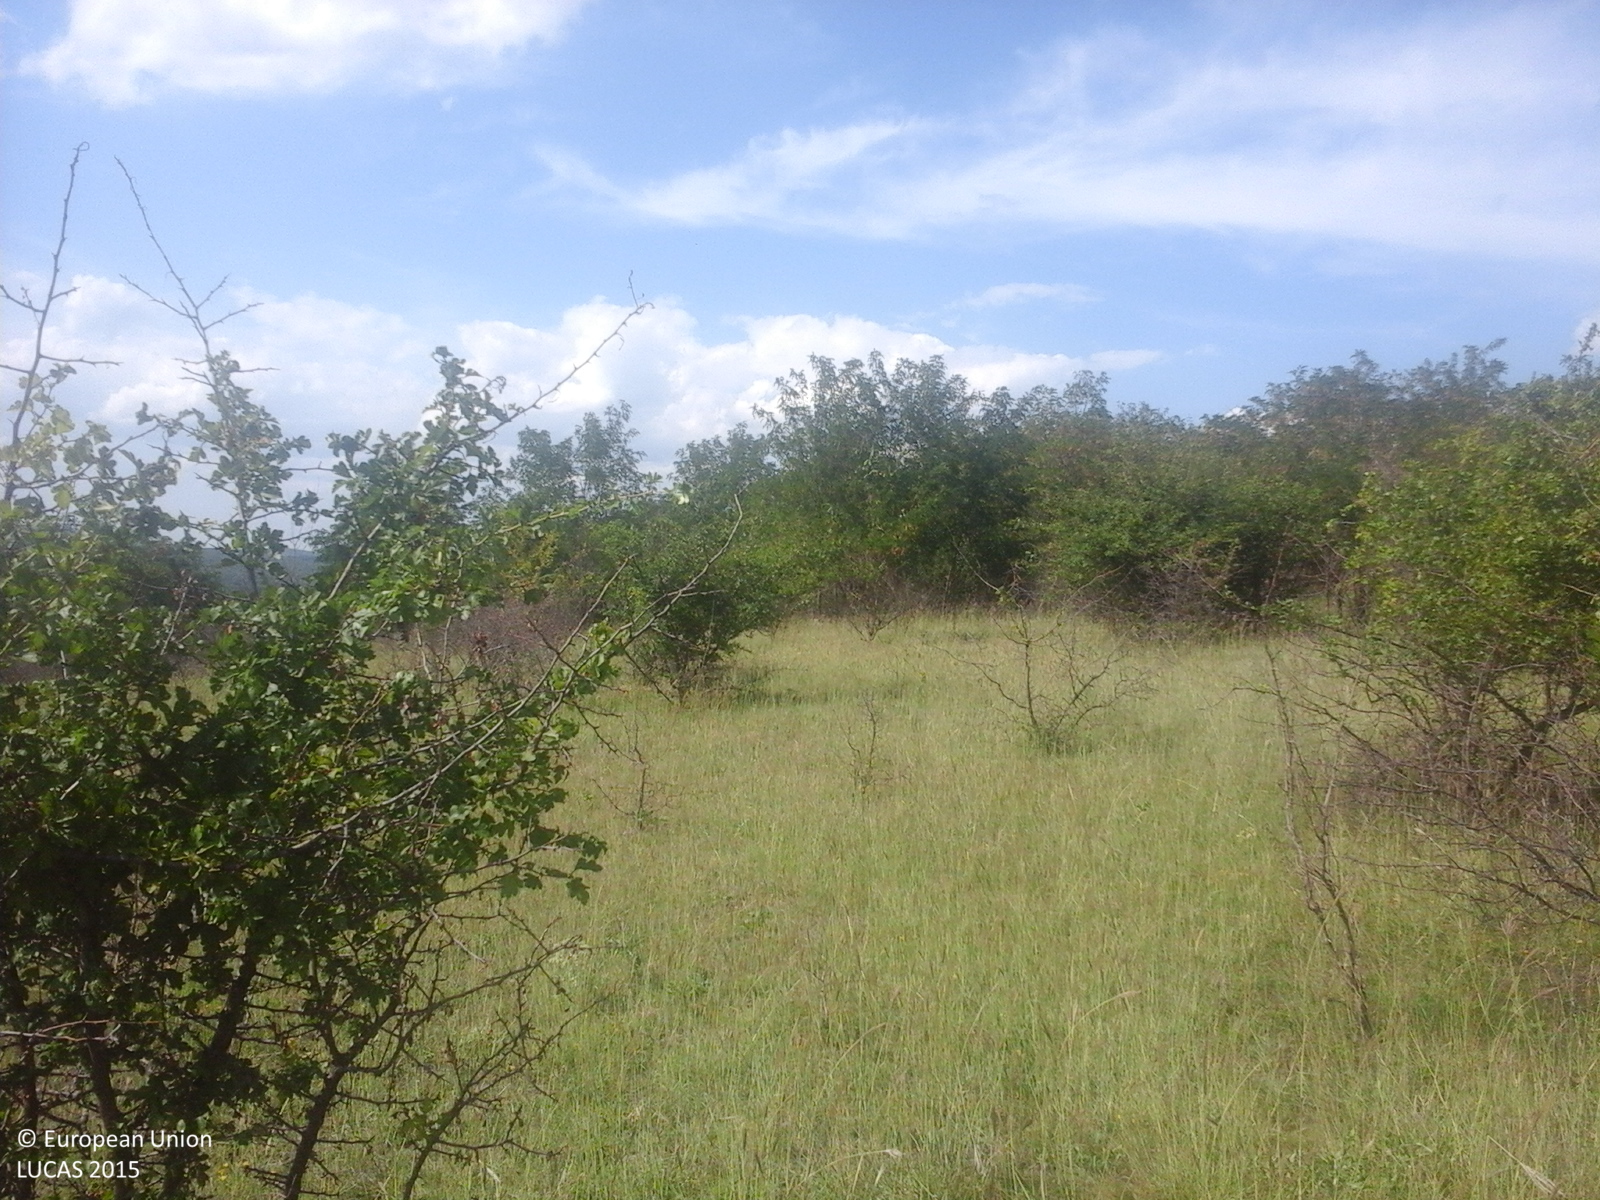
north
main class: Grassland
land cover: Grassland with sparse tree/shrub cover
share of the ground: > 75 %
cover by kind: herbaceous plants 85 %, shrubs 10 %, broadleaved forest trees 5 %
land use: Agriculture (excluding fallow land and kitchen gardens)
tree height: < 5 m
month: July
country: RO
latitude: 46.4879
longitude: 27.9864
